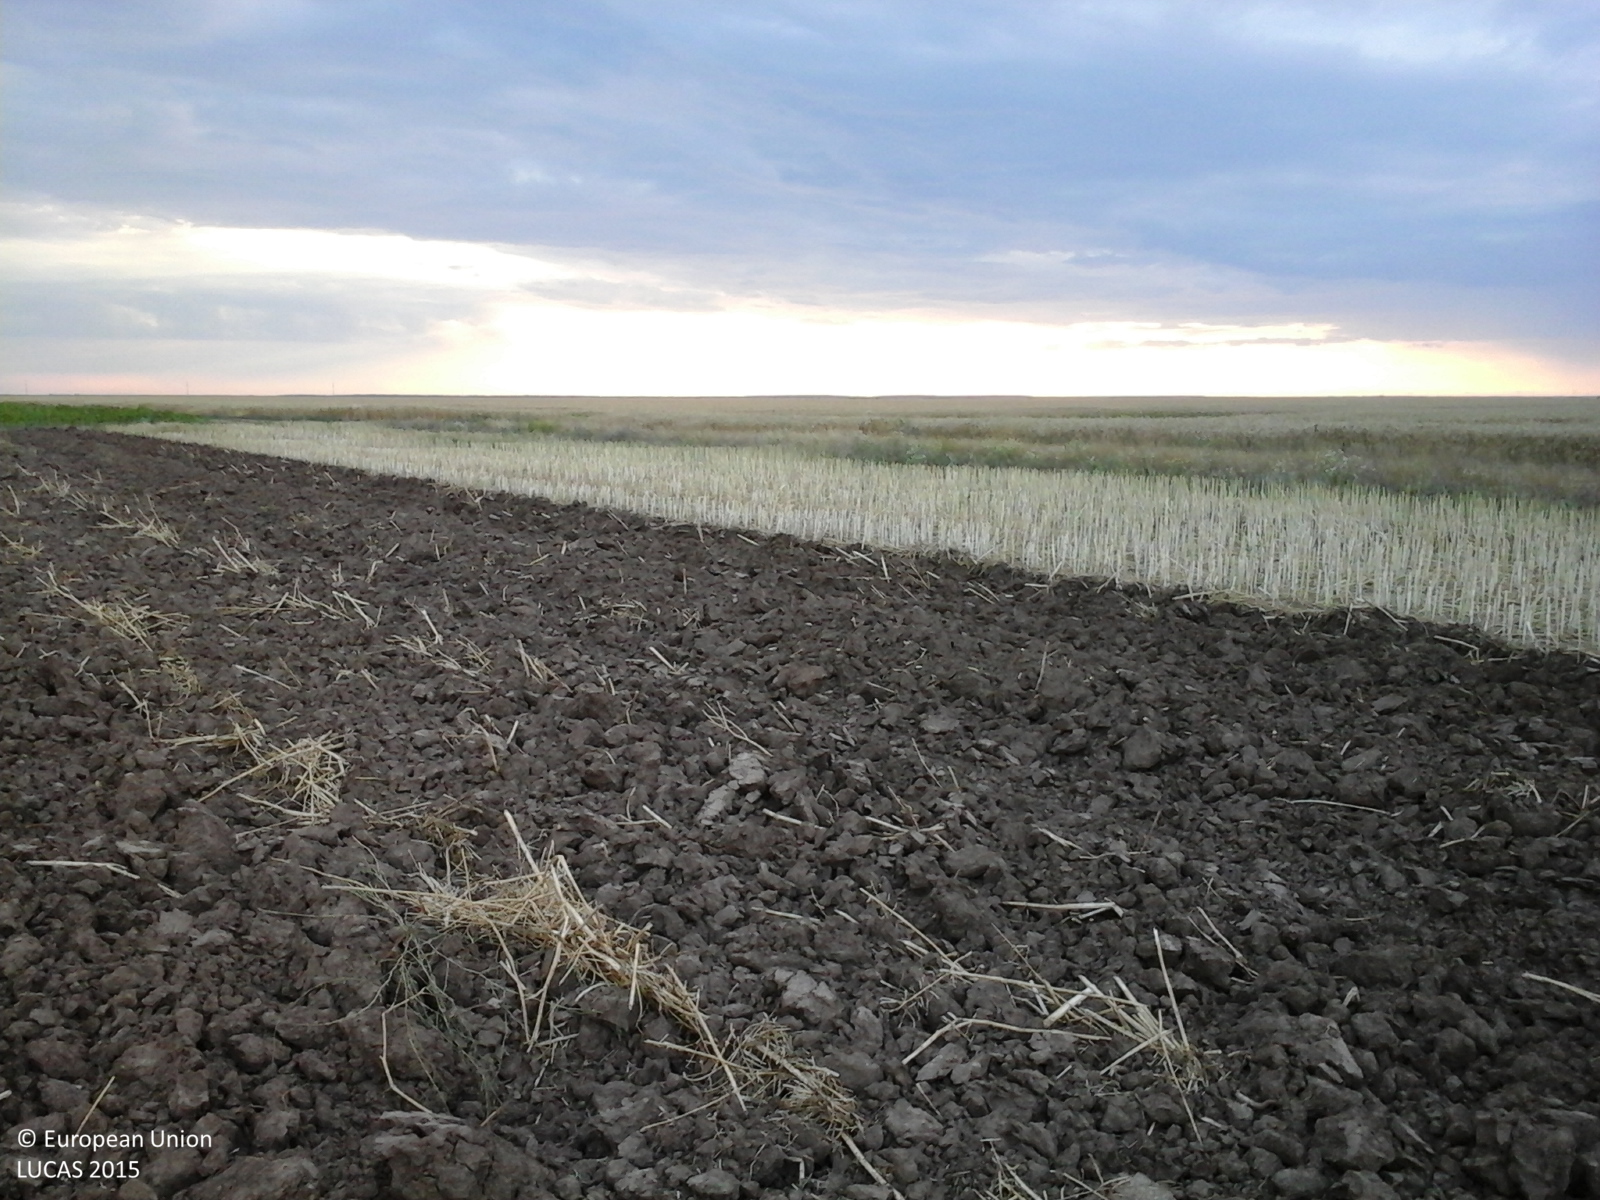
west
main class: Cropland
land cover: Rape and turnip rape
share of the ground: < 10 %
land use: Agriculture (excluding fallow land and kitchen gardens)
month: July
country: RO
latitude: 44.2136
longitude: 25.3168
